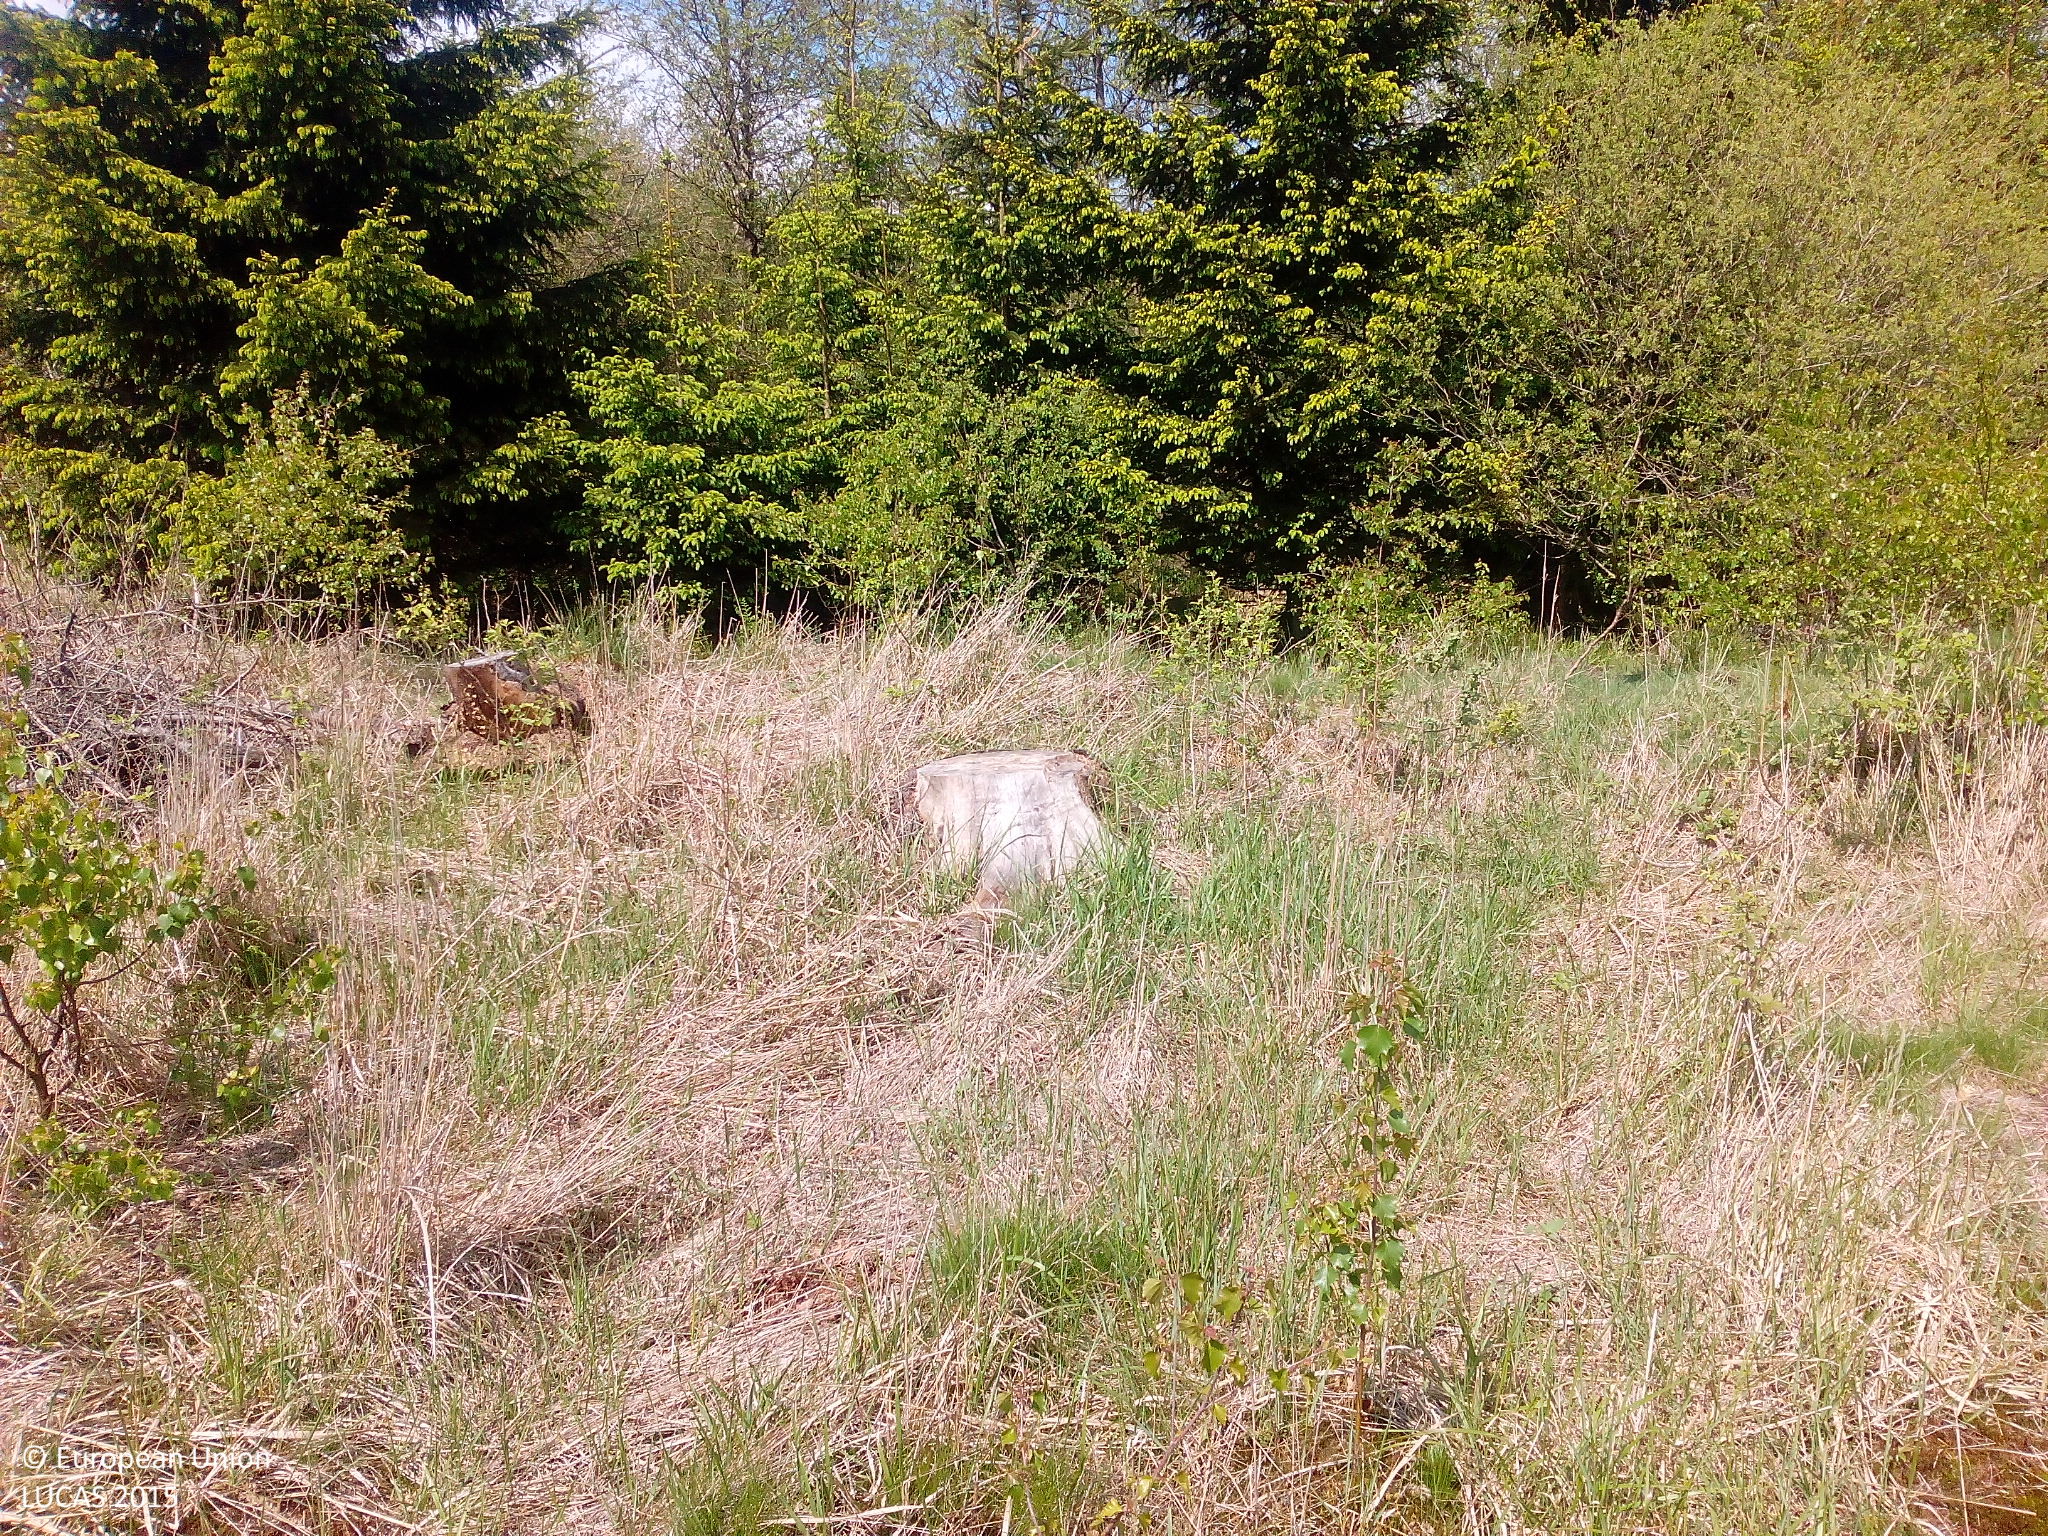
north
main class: Grassland
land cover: Grassland with sparse tree/shrub cover
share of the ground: > 75 %
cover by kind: herbaceous plants 45 %, lichens and mosses 40 %, unconsolidated bare surface 10 %, broadleaved forest trees 5 %
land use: Forestry
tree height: < 5 m
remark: Clear cut
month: May
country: DE
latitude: 51.3151
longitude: 9.3546
